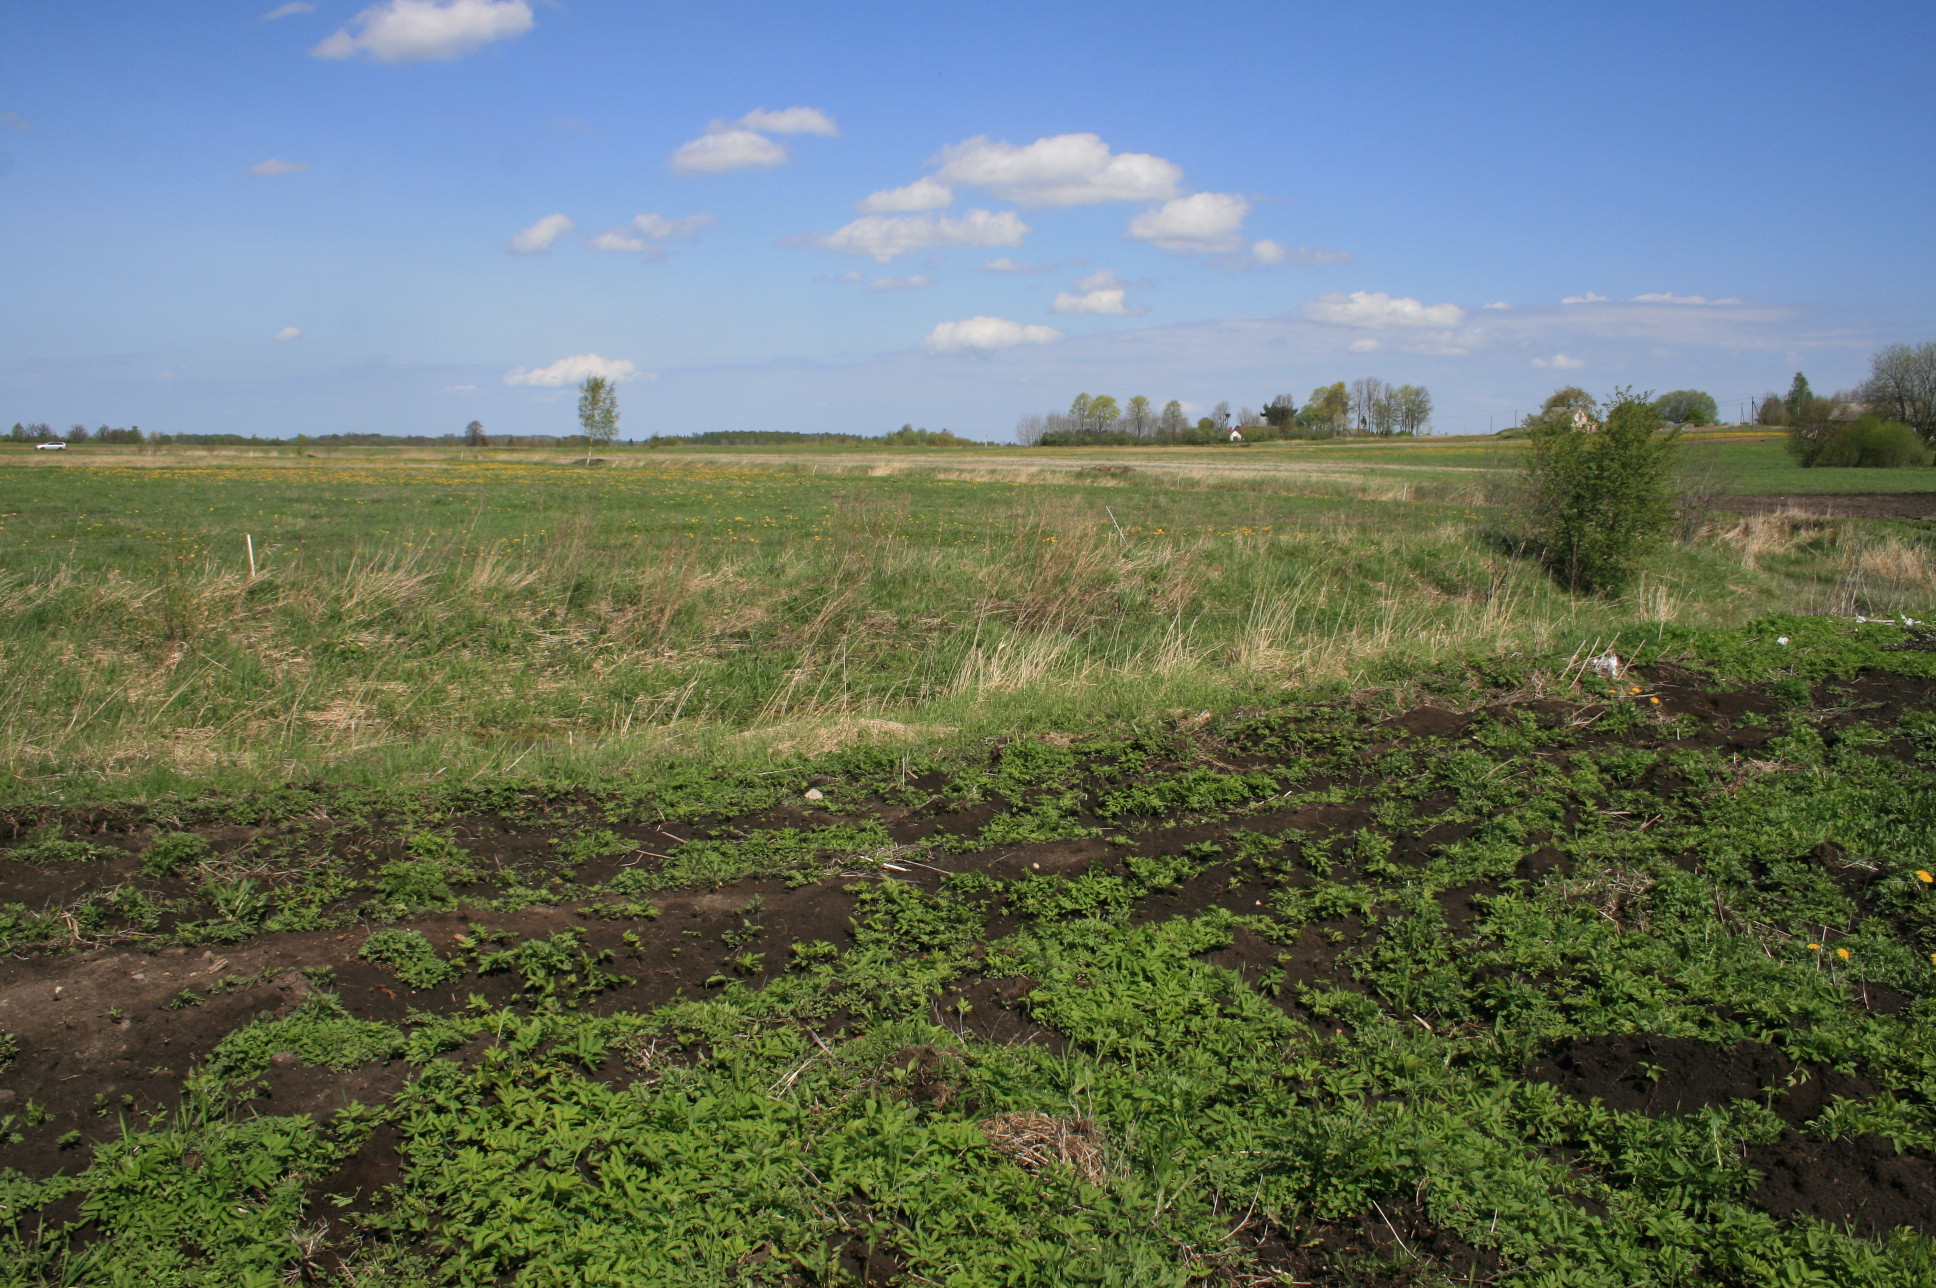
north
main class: Grassland
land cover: Spontaneously vegetated surfaces
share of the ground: 50 - 75 %
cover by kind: herbaceous plants 65 %, unconsolidated bare surface 35 %
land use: Fallow land
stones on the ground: < 10 %
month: May
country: LT
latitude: 56.2992
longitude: 21.5660
